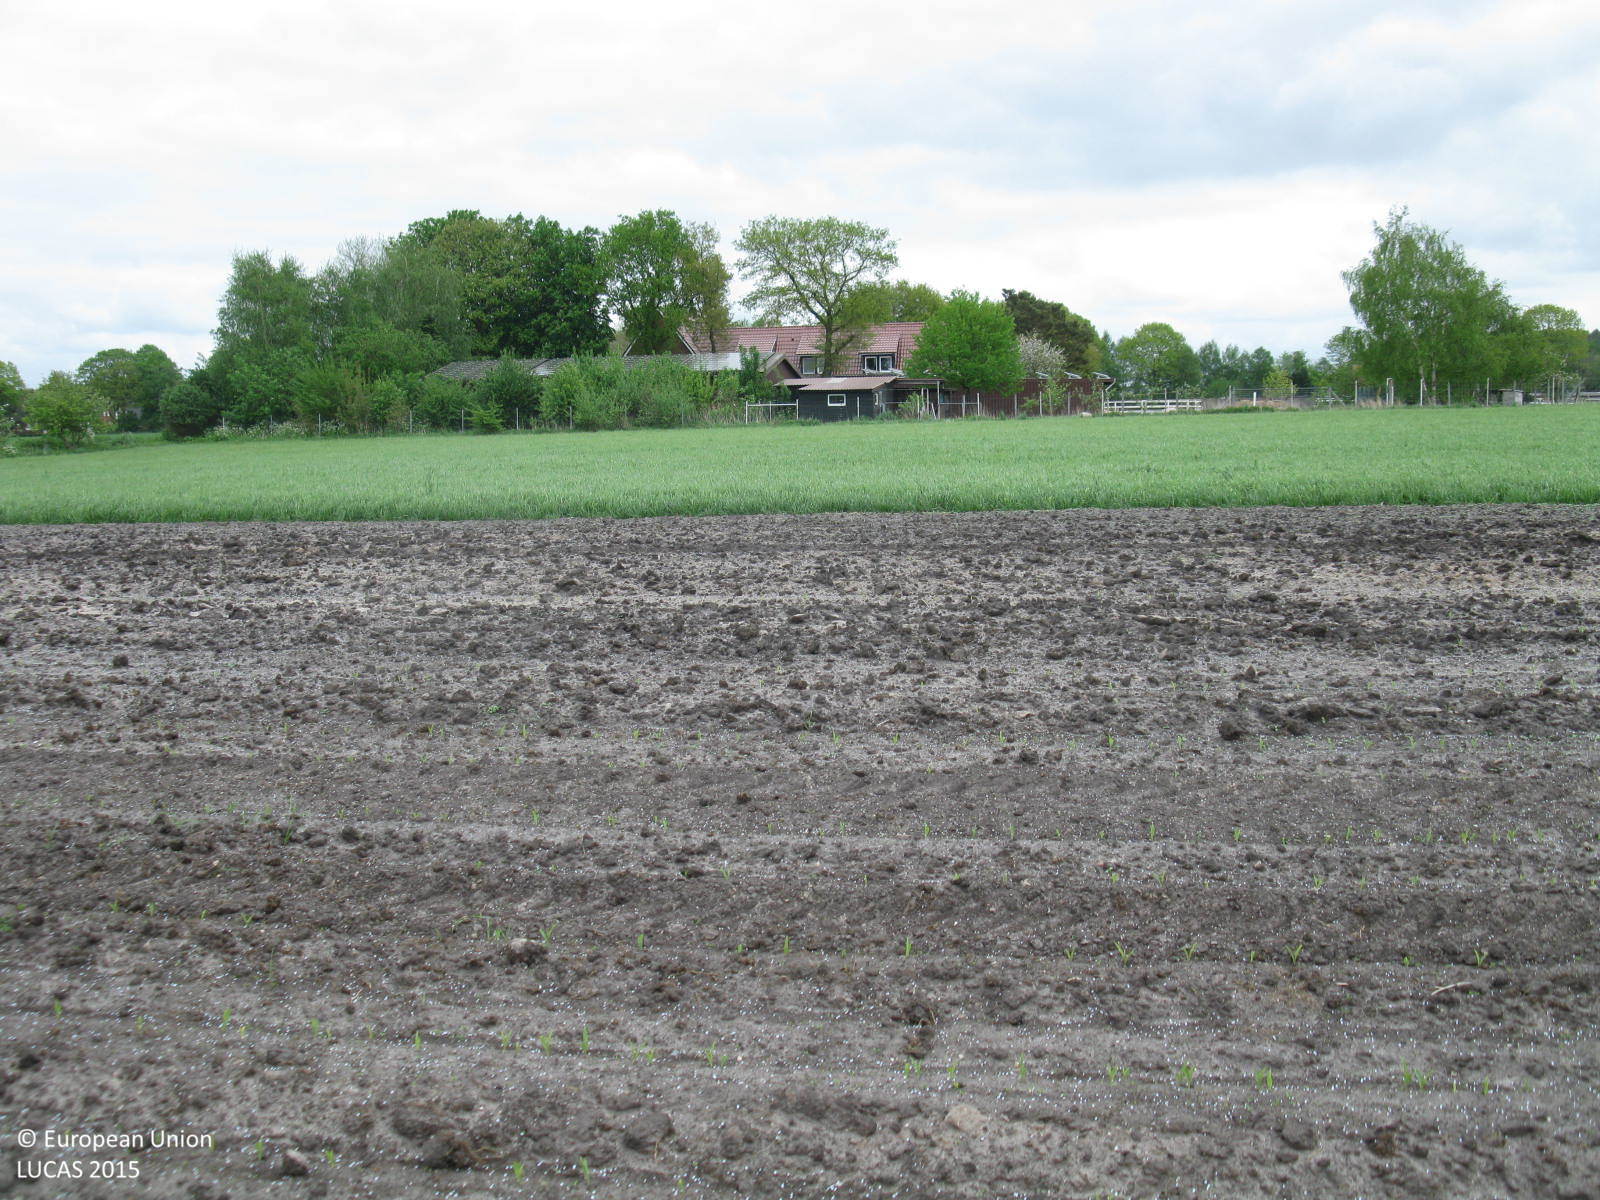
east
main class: Cropland
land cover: Maize
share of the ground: < 10 %
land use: Agriculture (excluding fallow land and kitchen gardens)
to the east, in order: Maize; Temporary grasslands; Artificial constructions in urban areas; Broadleaved woodland; Triticale
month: May
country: DE
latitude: 52.8520
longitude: 7.3720
